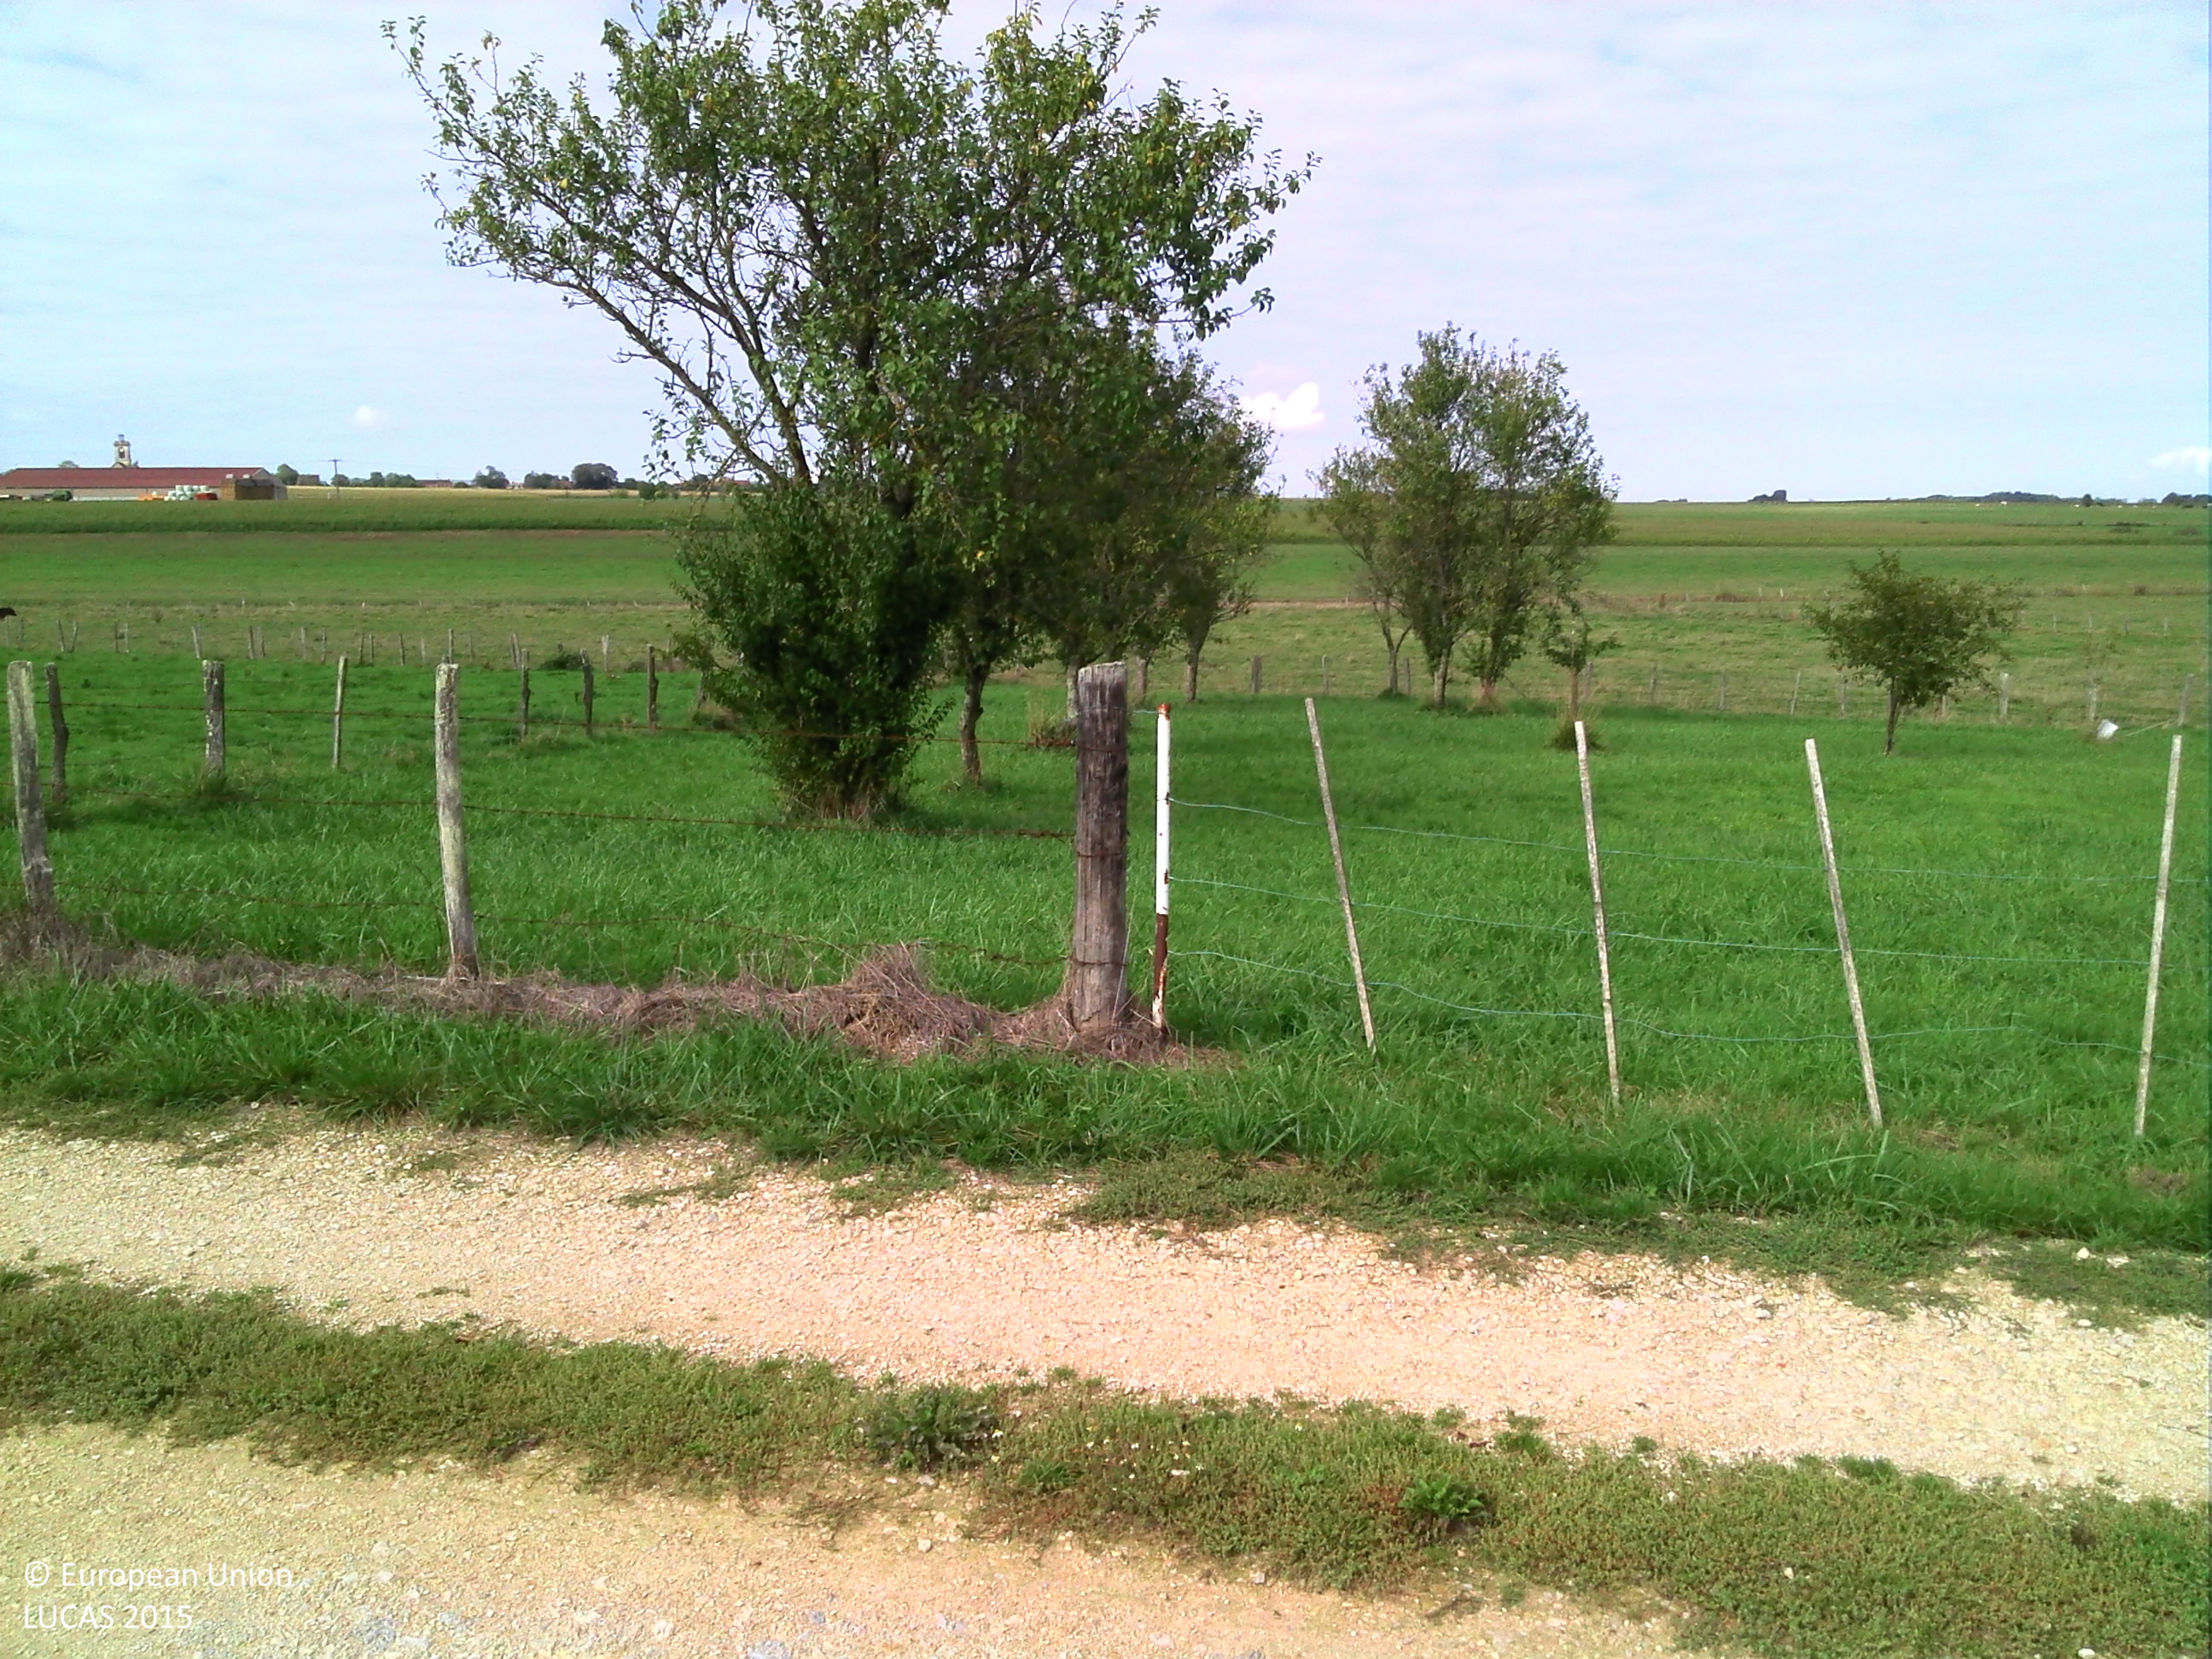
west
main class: Grassland
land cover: Grassland without tree/shrub cover
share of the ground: > 75 %
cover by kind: herbaceous plants 100 %
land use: Agriculture (excluding fallow land and kitchen gardens)
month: September
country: FR
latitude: 48.3816
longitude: 4.6373
